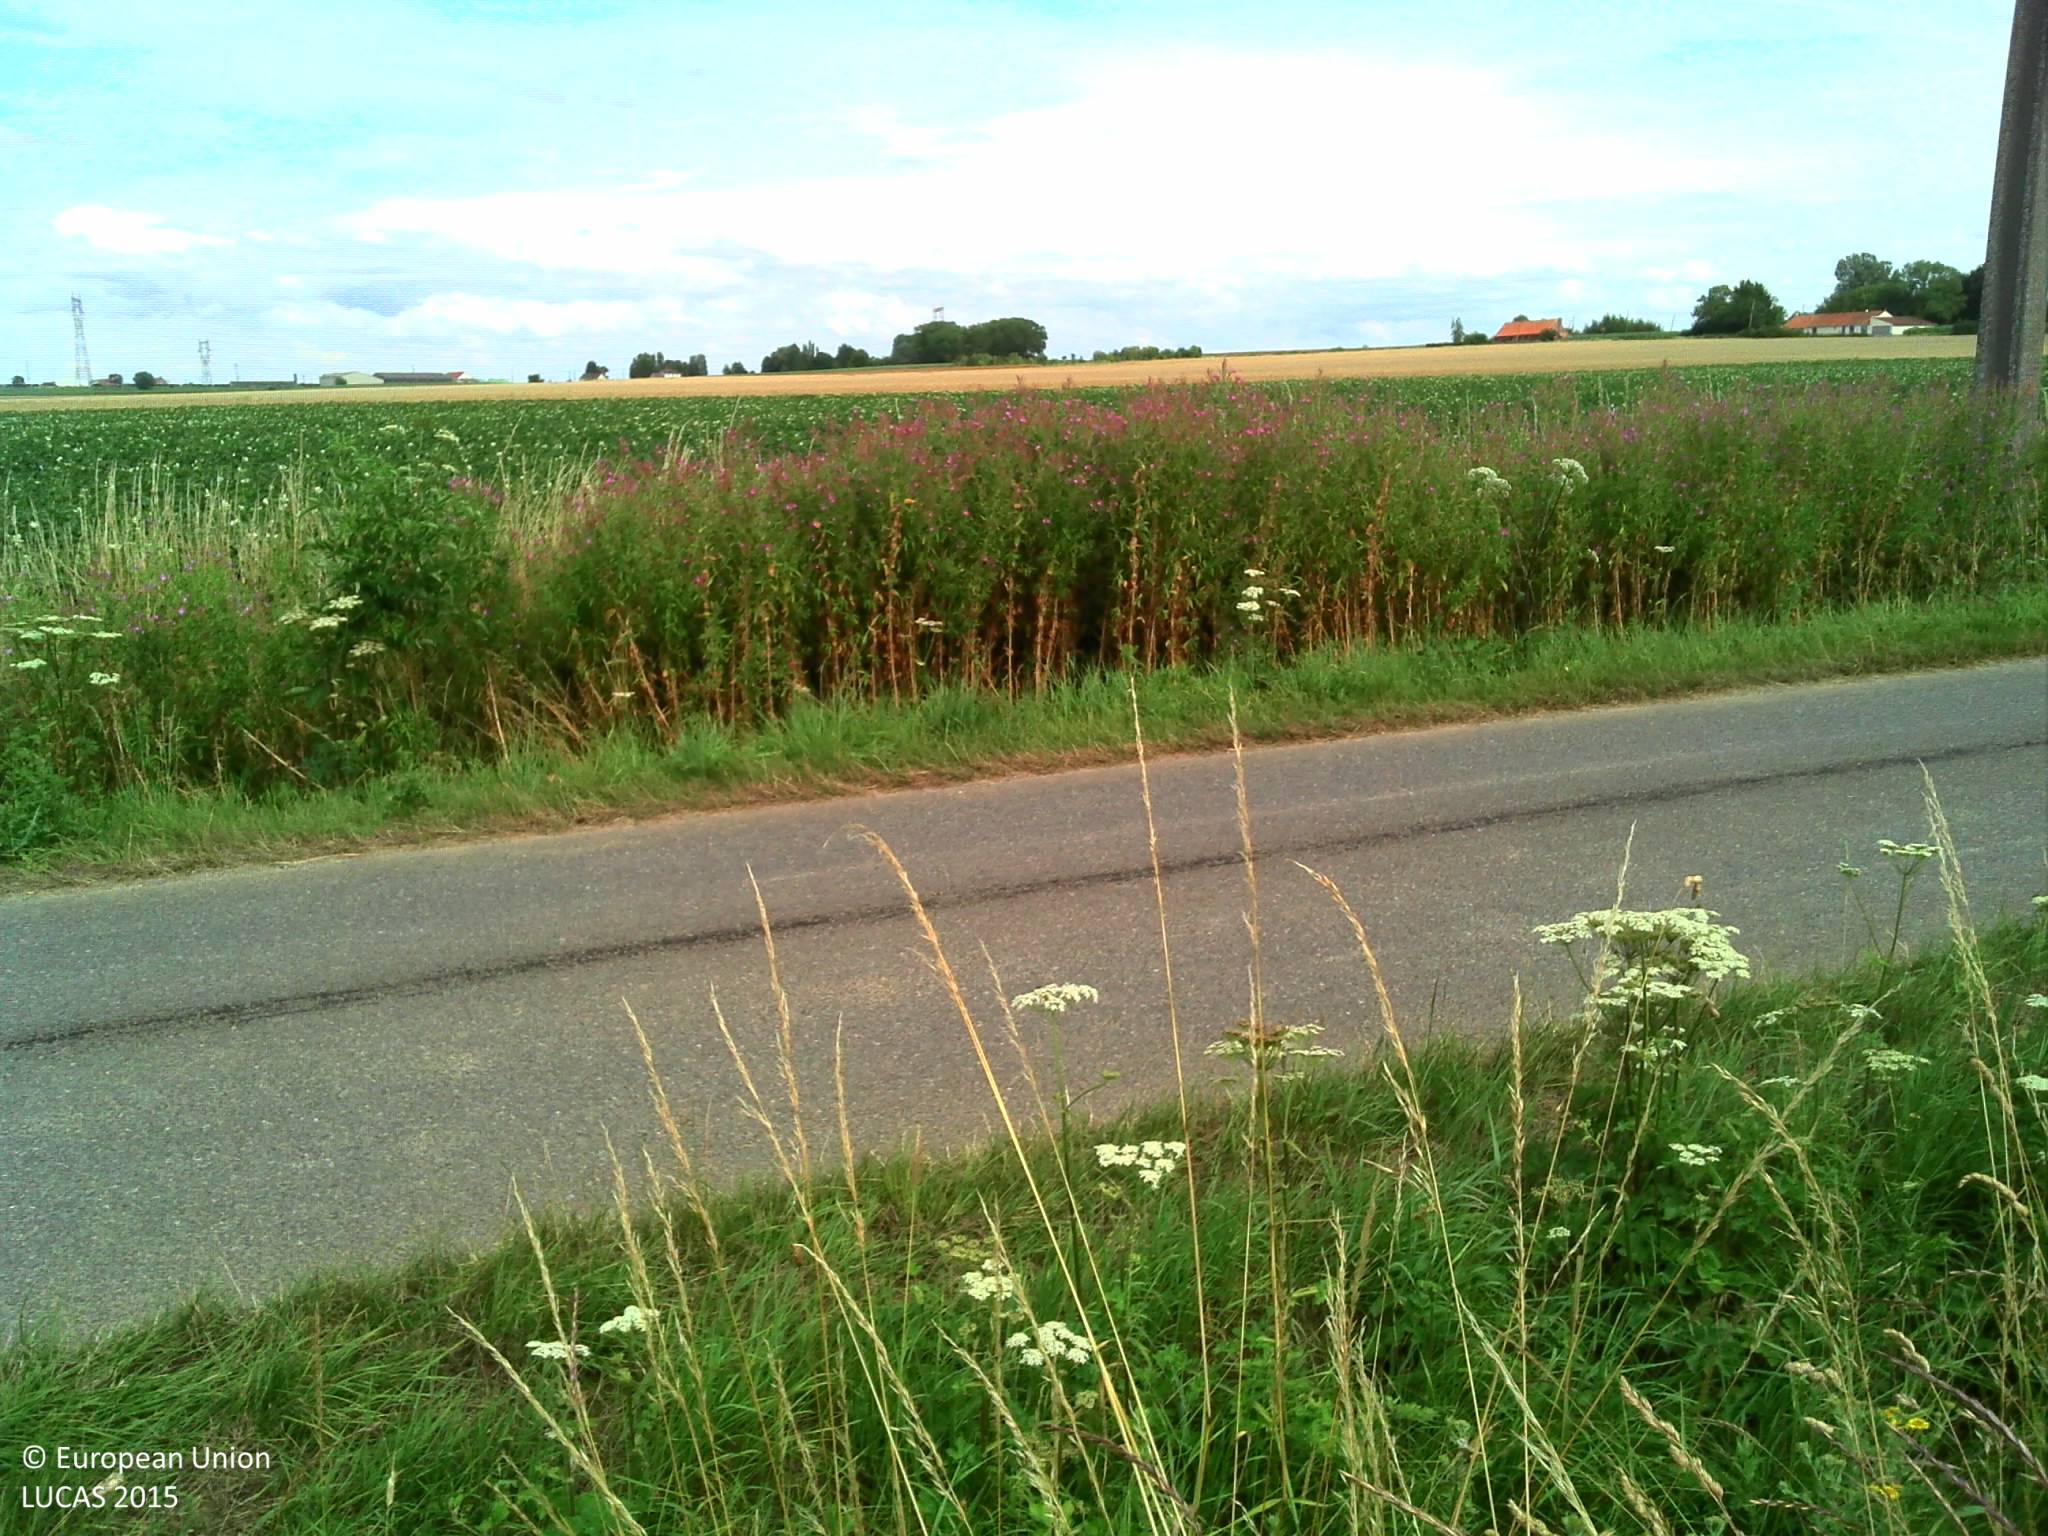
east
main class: Cropland
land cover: Durum wheat
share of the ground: > 75 %
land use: Agriculture (excluding fallow land and kitchen gardens)
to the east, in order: Durum wheat; Grass margins; Electric lines; Ditches and canals; Grass margins; Paved roads, cycling and walking lanes; Grass margins; Electric lines; Ditches and canals; Grass margins; Potatoes; Durum wheat
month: July
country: FR
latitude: 50.7933
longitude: 2.3397
